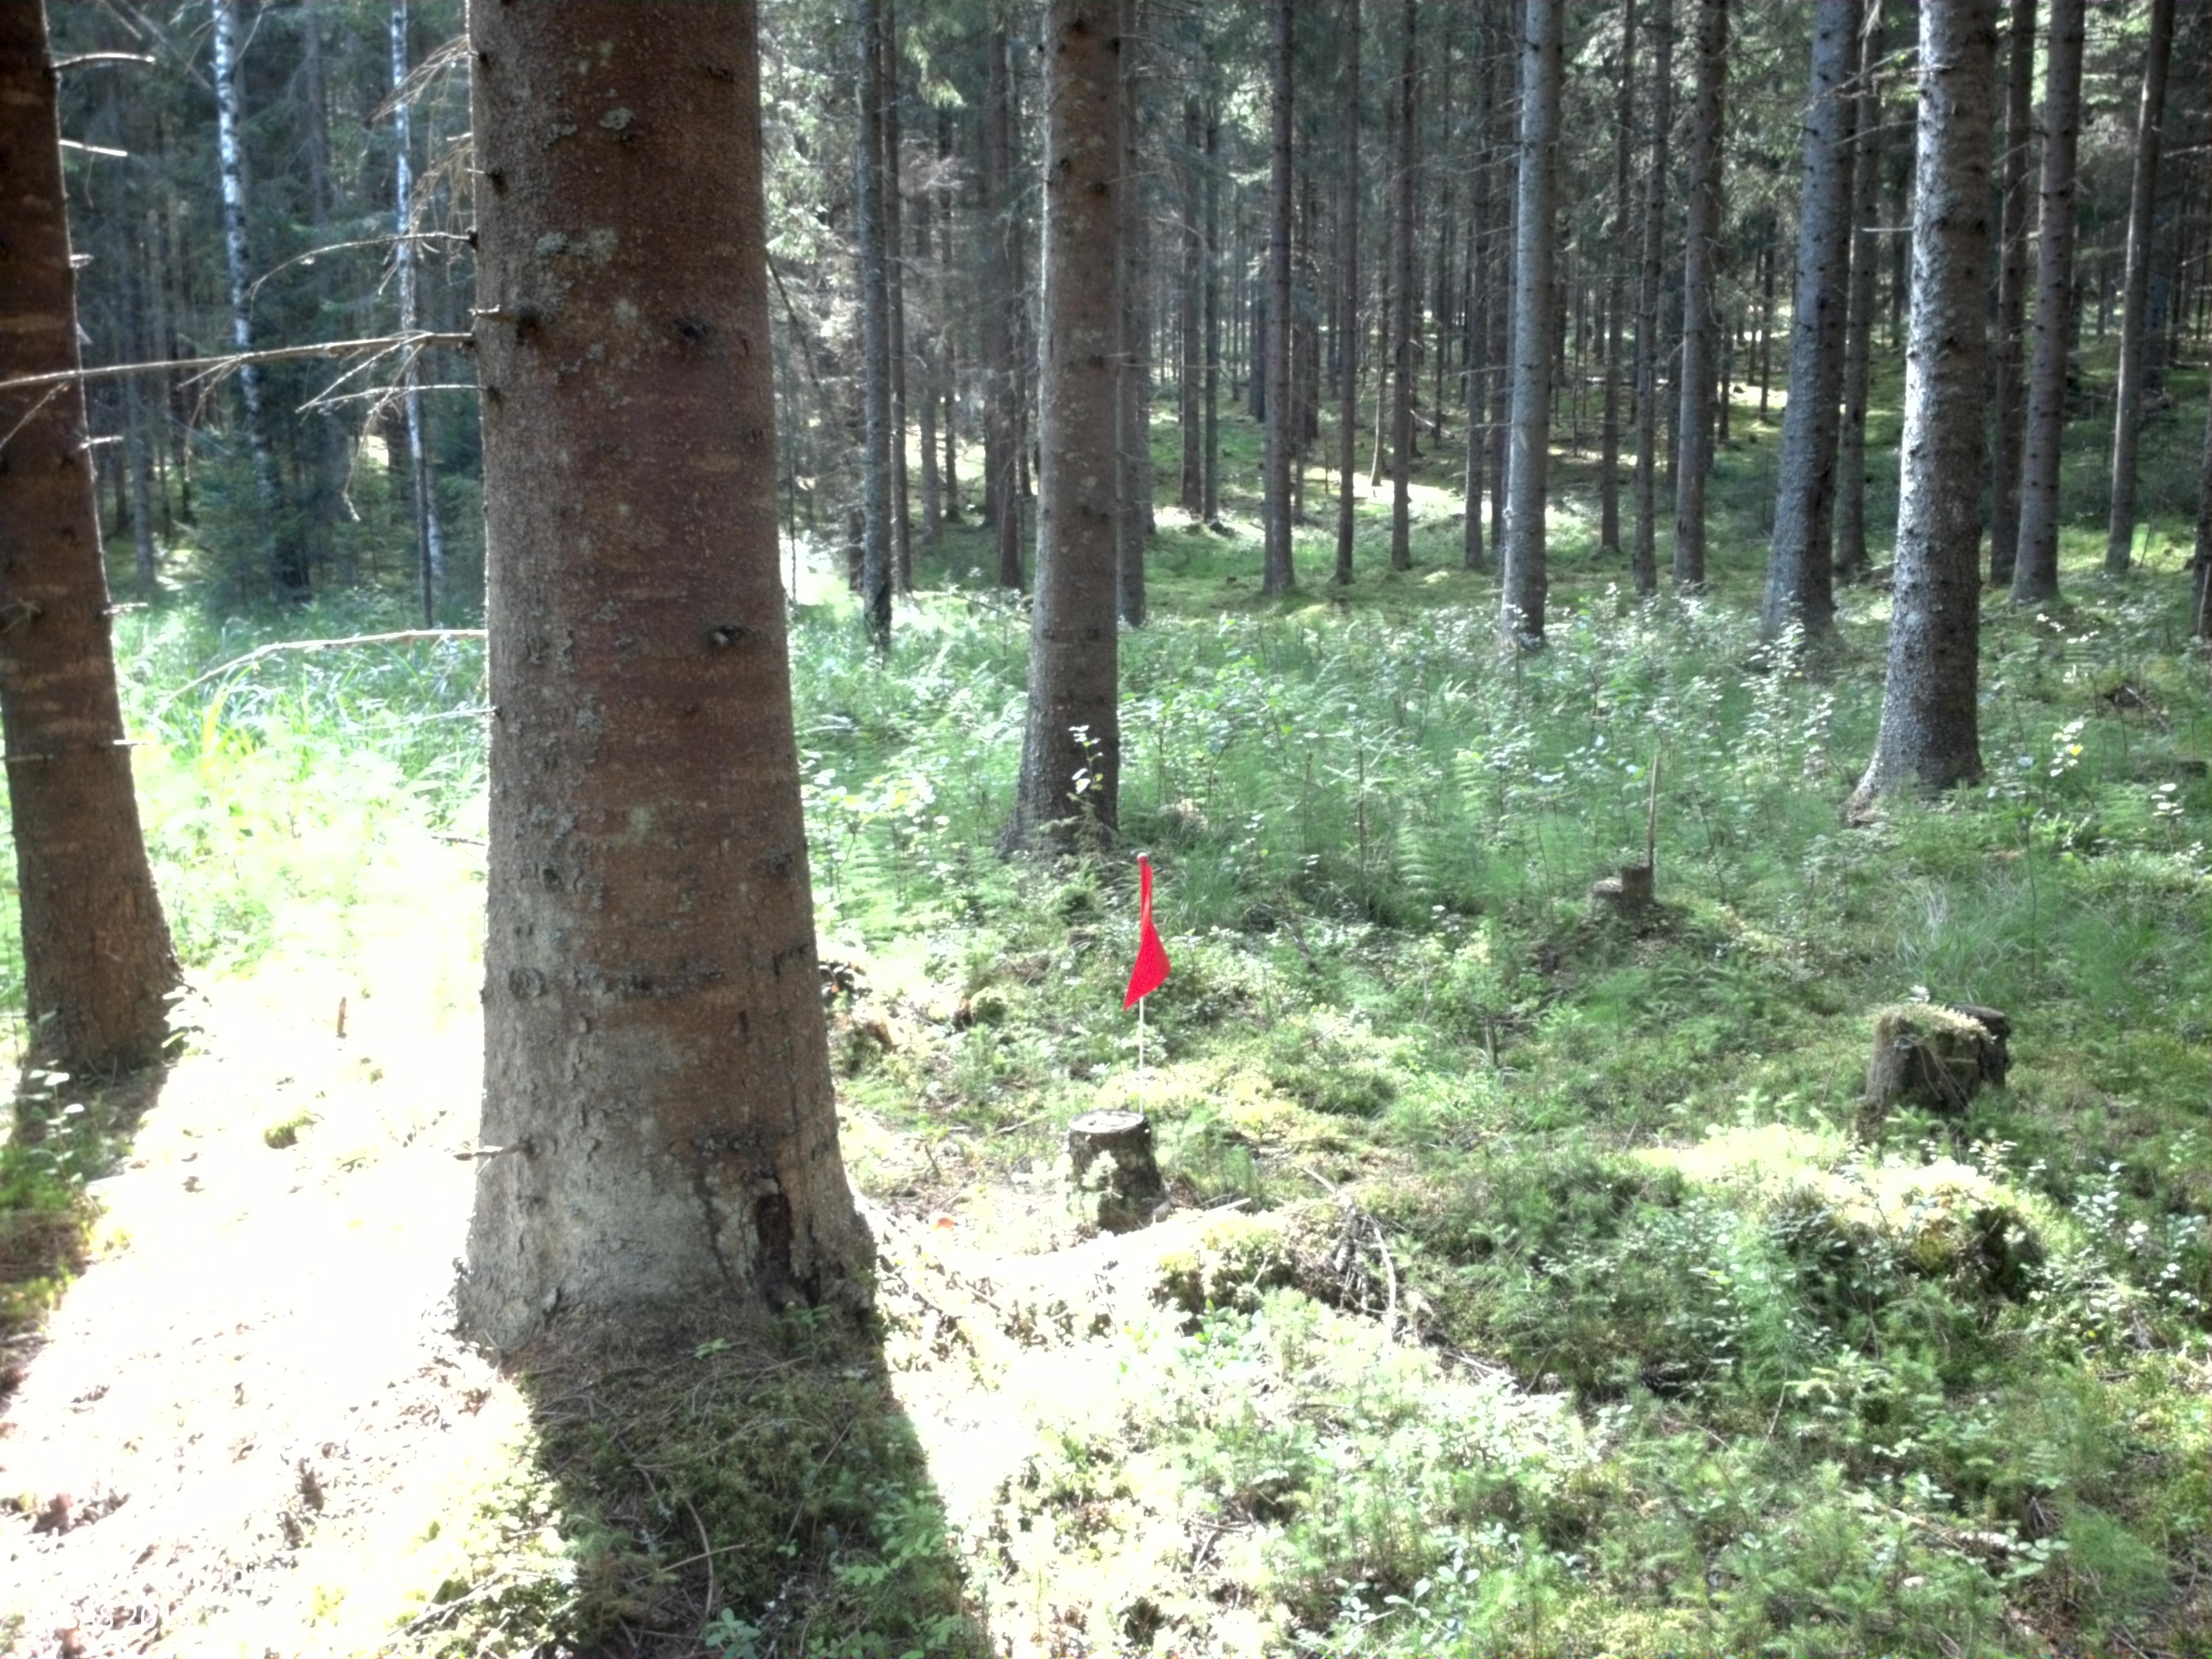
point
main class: Woodland
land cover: Spruce dominated coniferous woodland
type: boreal forest
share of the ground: 50 - 75 %
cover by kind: coniferous forest trees 65 %, shrubs 15 %, lichens and mosses 10 %, broadleaved forest trees 5 %, herbaceous plants 5 %
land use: Forestry
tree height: > 5 m
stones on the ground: < 10 %
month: August
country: SE
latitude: 60.0123
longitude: 13.4527
